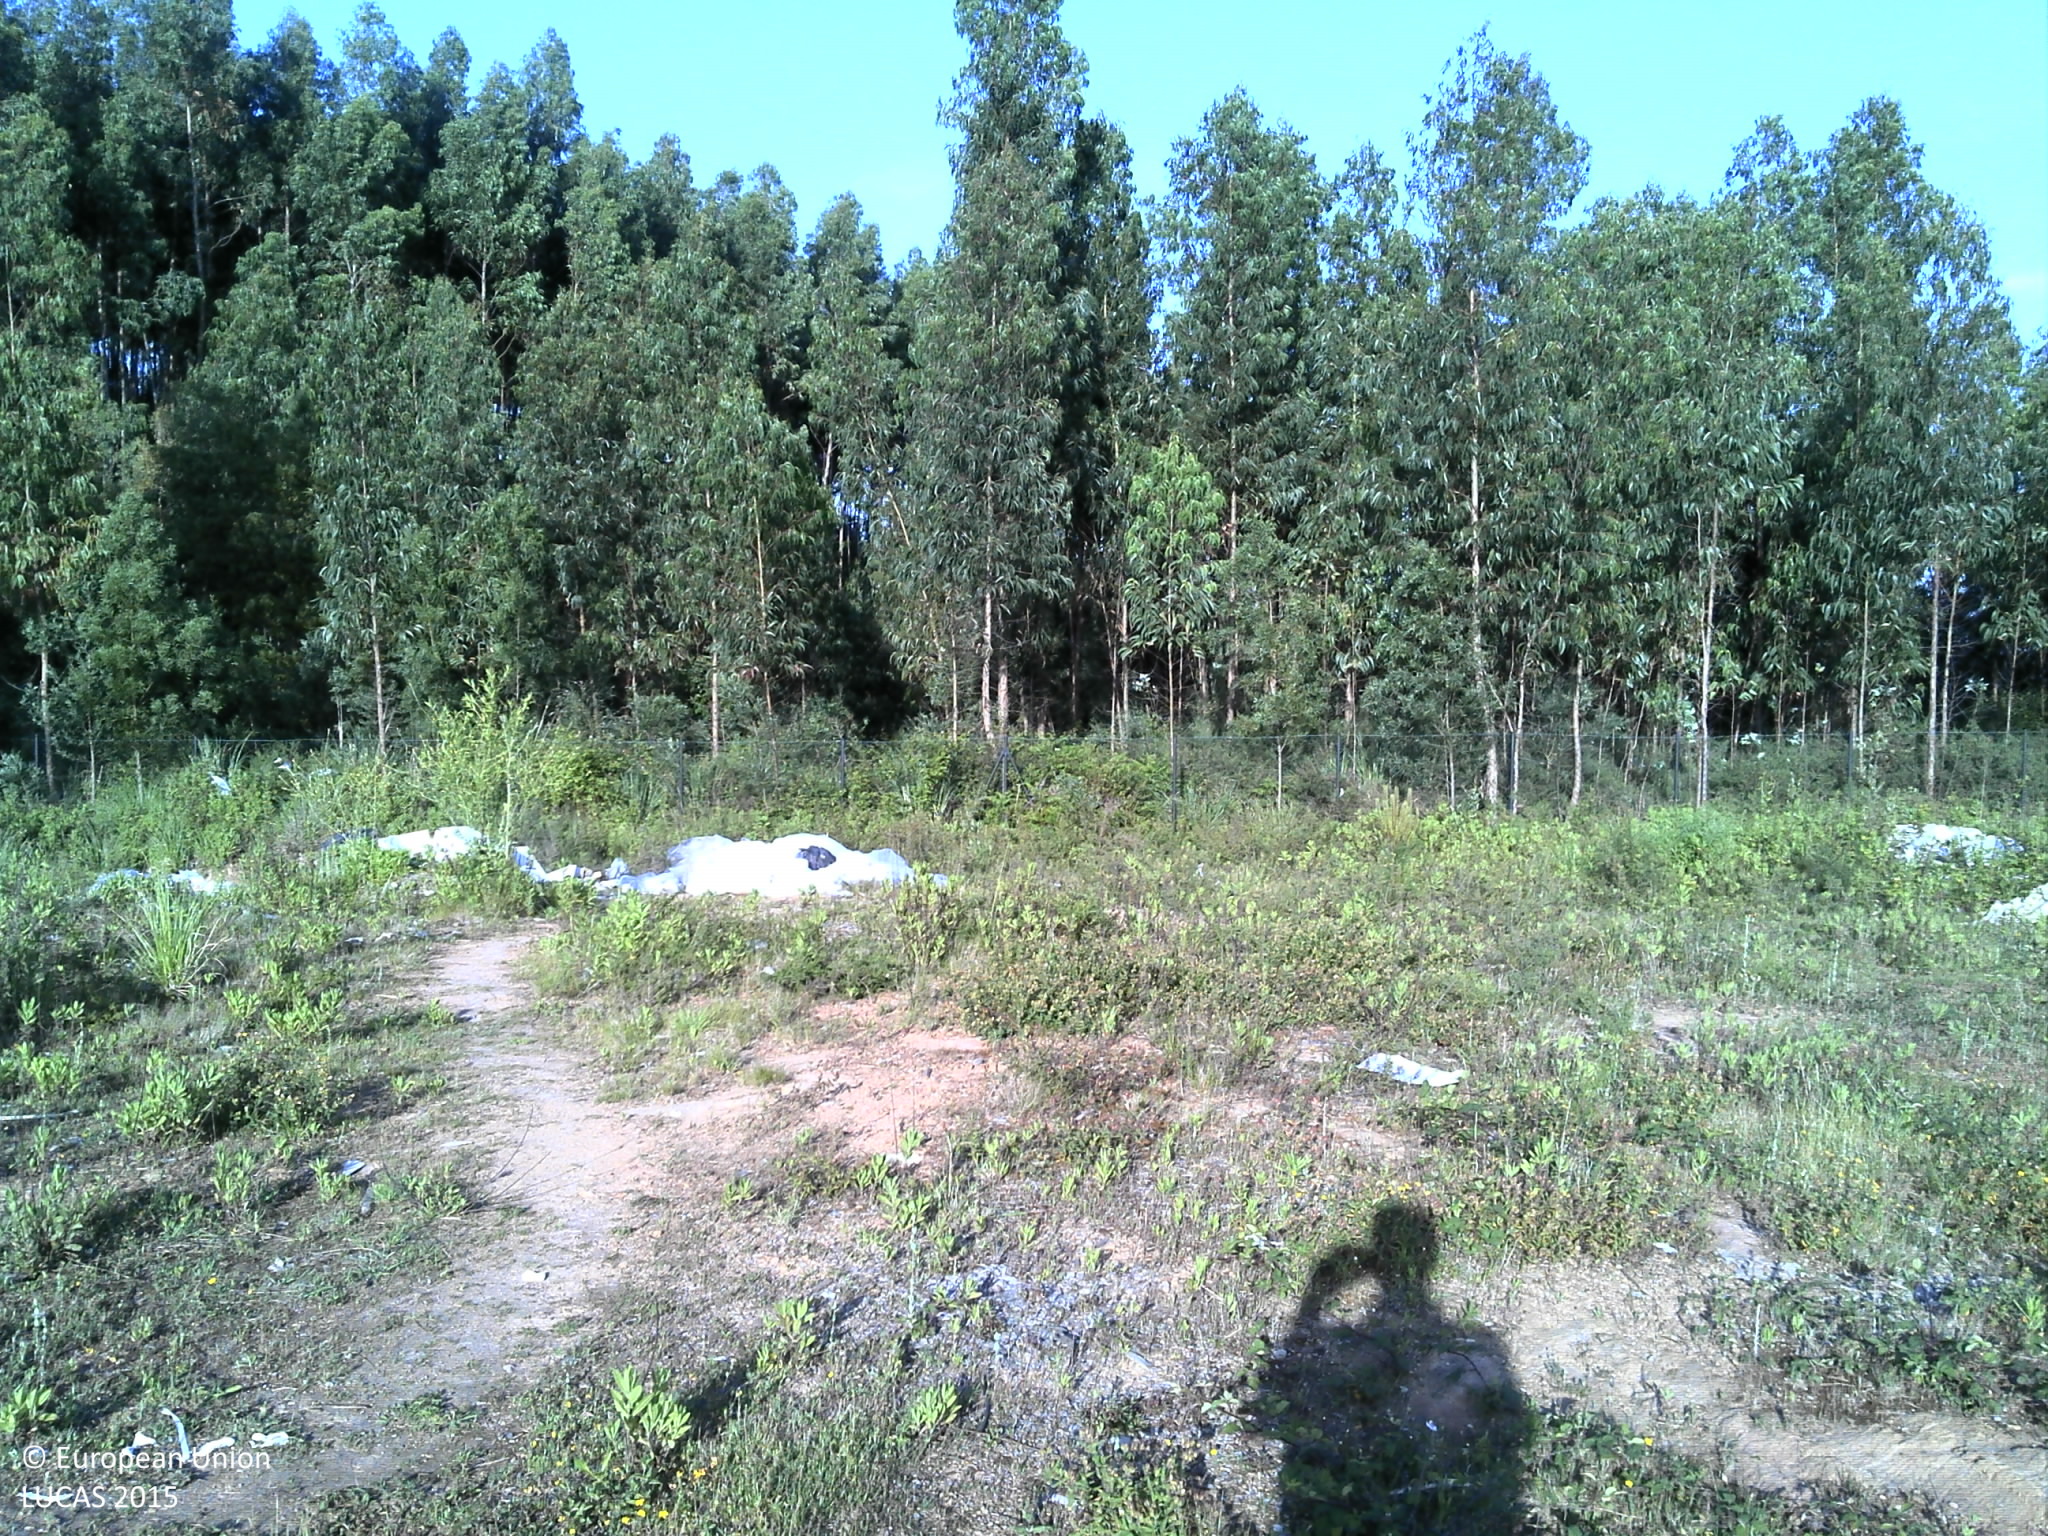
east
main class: Grassland
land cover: Spontaneously vegetated surfaces
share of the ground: 25 - 50 %
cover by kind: herbaceous plants 50 %, unconsolidated bare surface 50 %
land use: Abandoned areas
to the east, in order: Spontaneously vegetated surfaces; Fences; Broadleaved woodland; Dry stone walls; Tracks; Broadleaved woodland; Tracks; Broadleaved woodland; Tracks; Broadleaved woodland
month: May
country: PT
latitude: 41.3700
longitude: -8.5297
